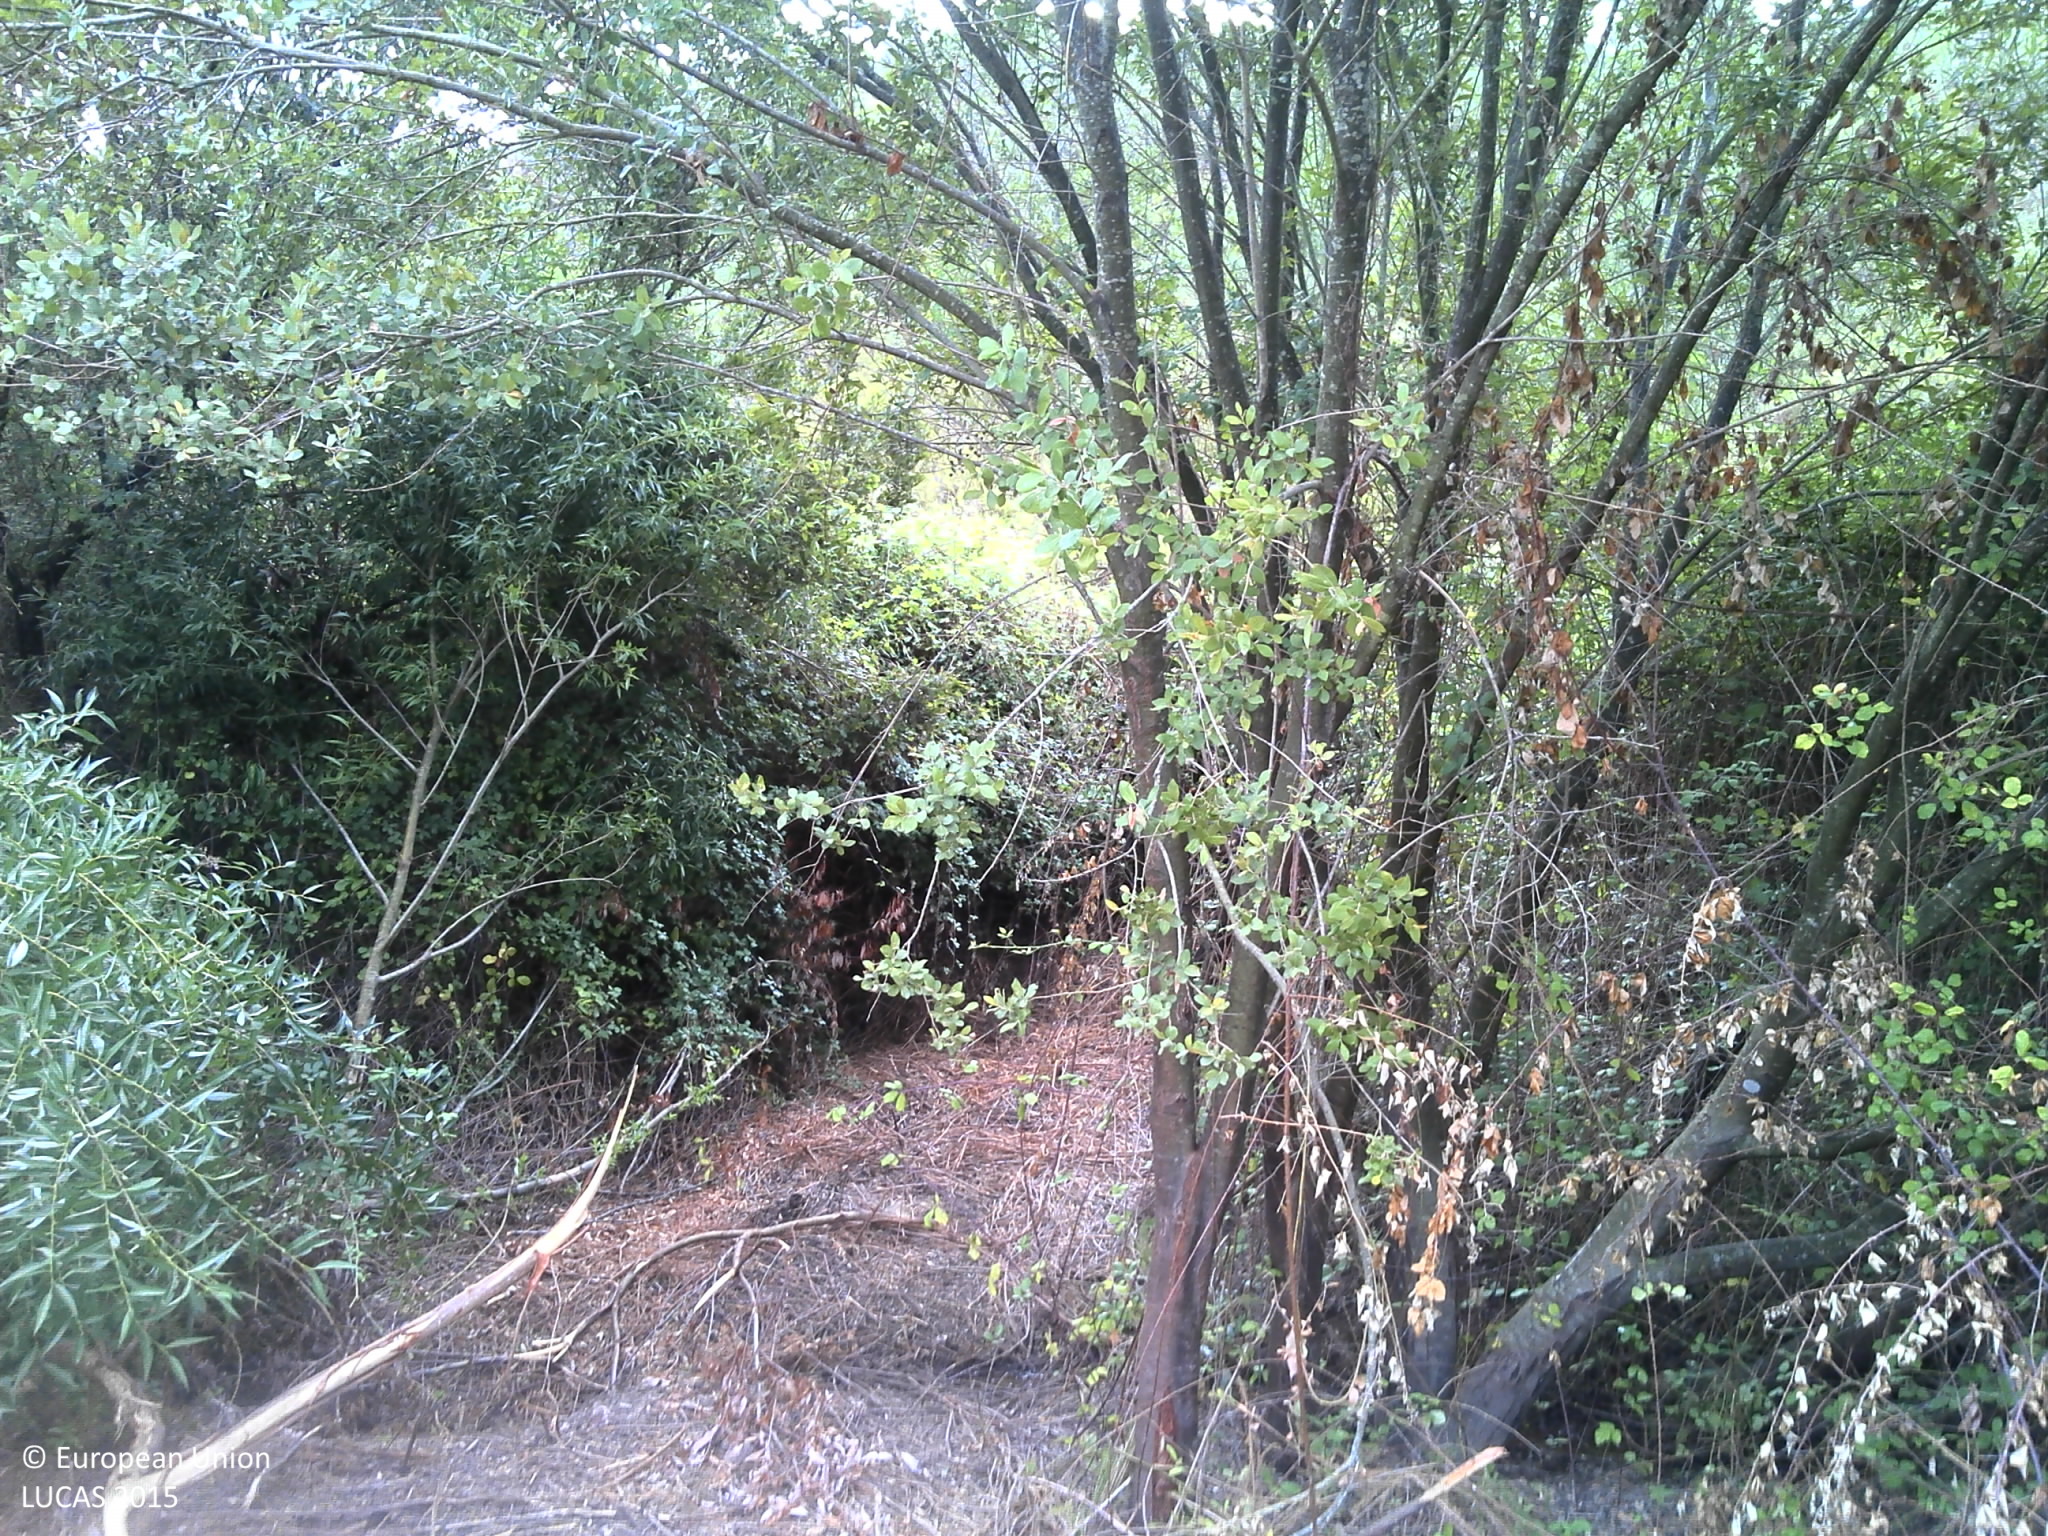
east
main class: Shrubland
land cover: Shrubland without tree cover
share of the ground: > 75 %
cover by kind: shrubs 80 %, unconsolidated bare surface 20 %
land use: Forestry
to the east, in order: Shrubland without tree cover; Tracks; Broadleaved woodland; Tracks; Broadleaved woodland; Tracks; Shrubland without tree cover; Tracks
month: July
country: PT
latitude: 37.3850
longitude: -8.7508
